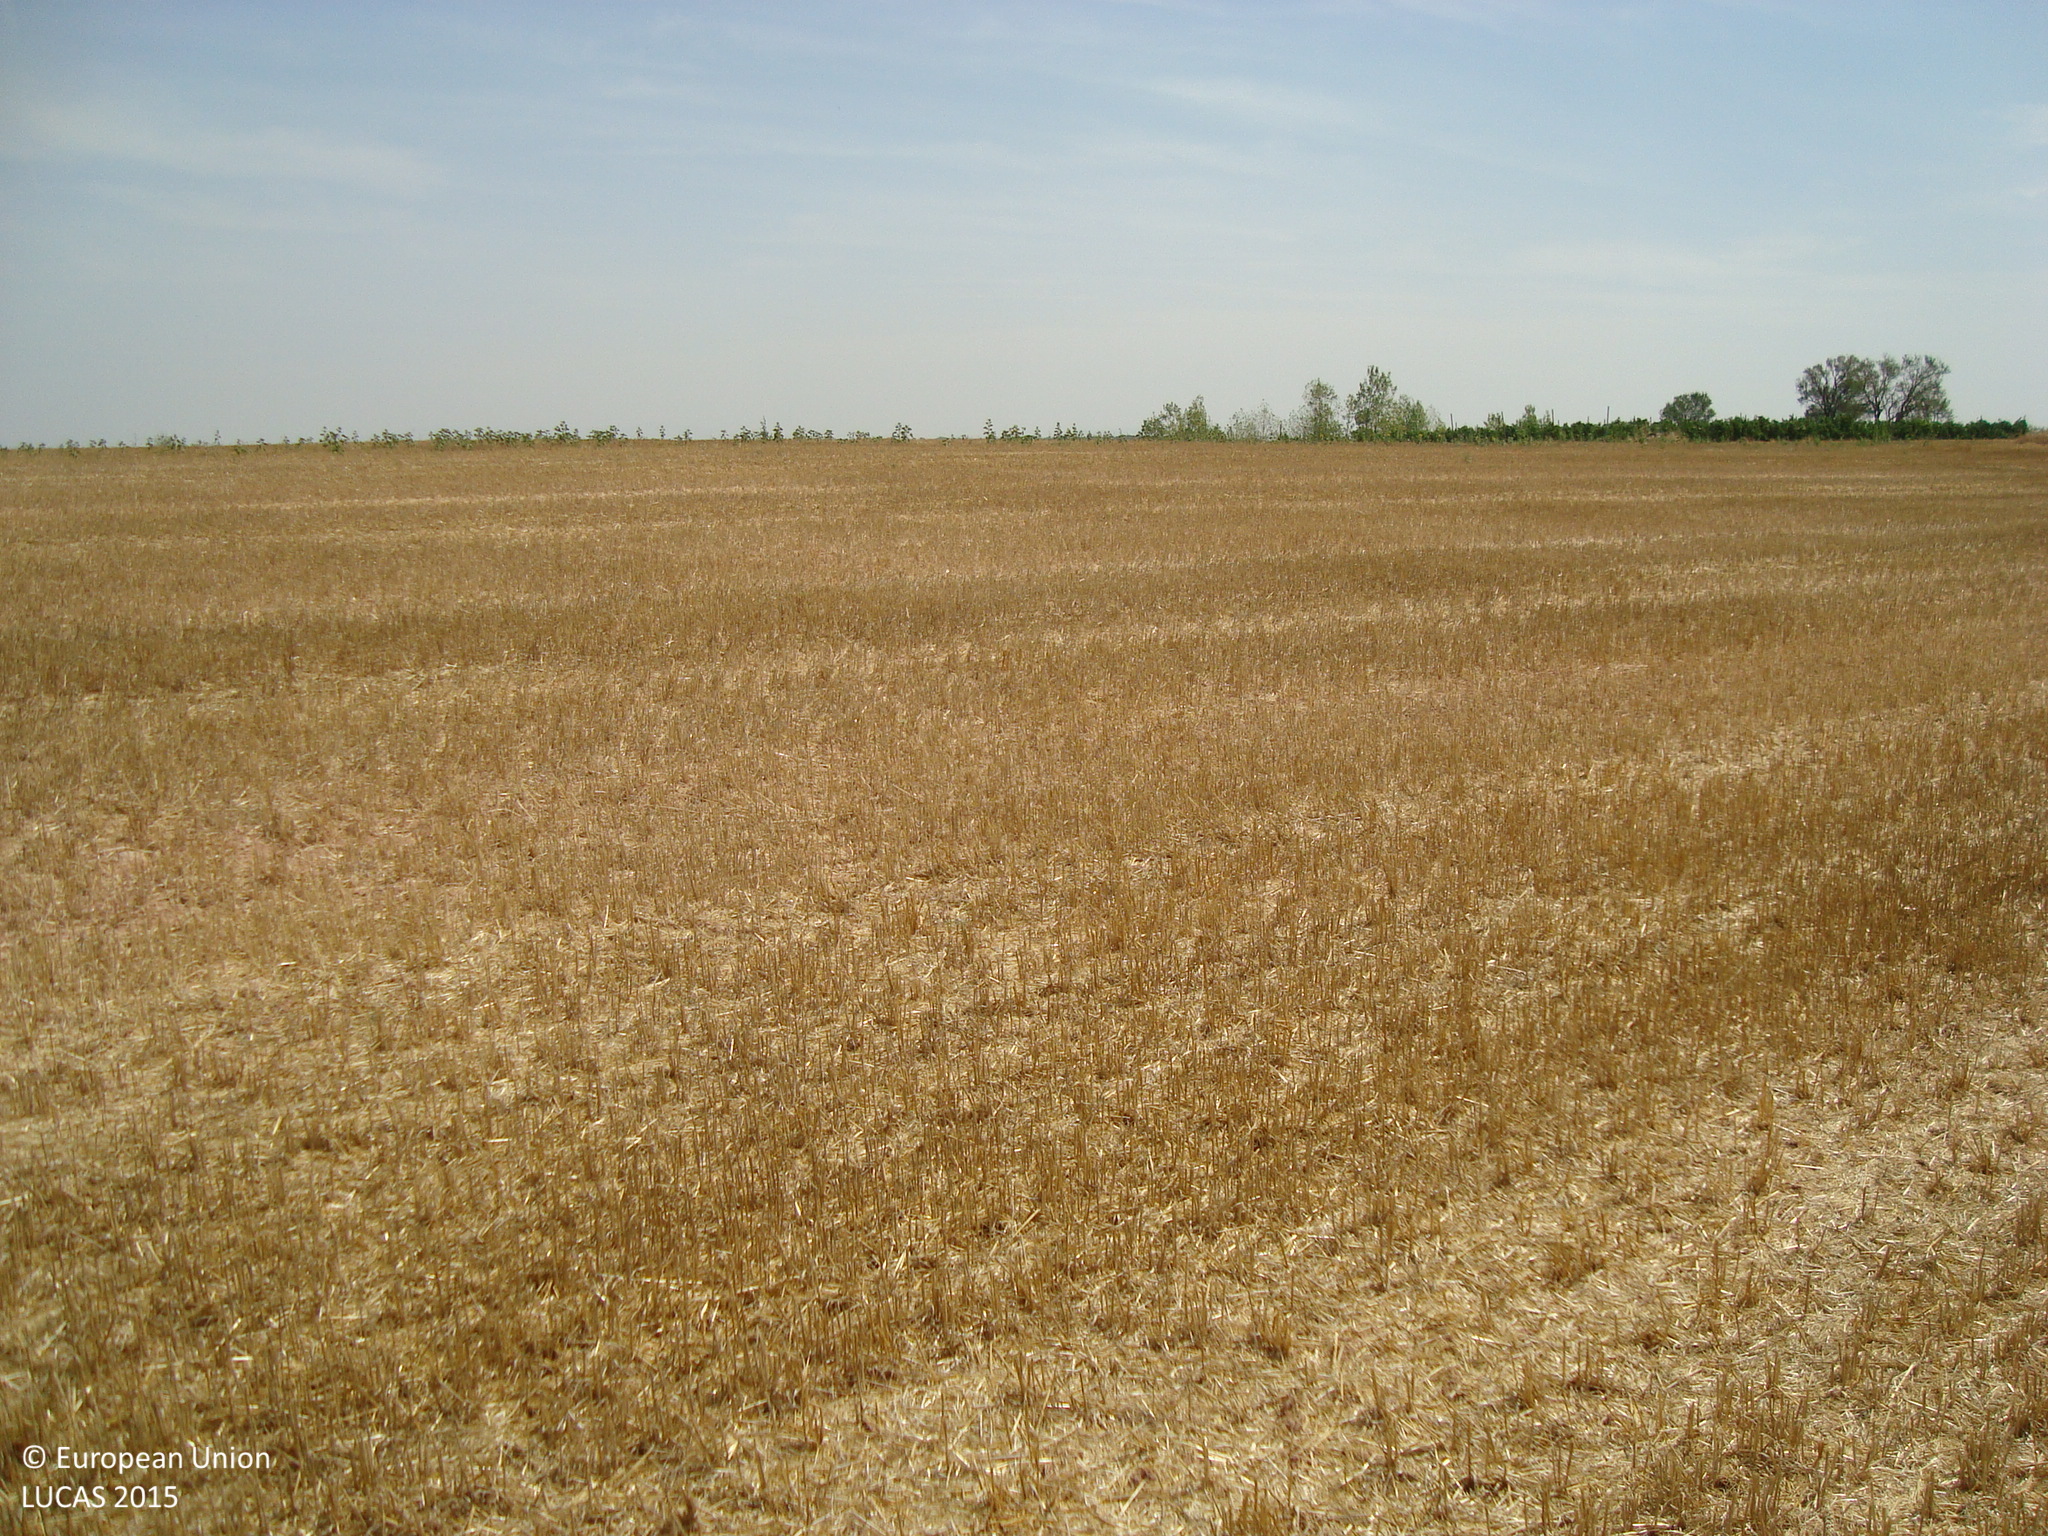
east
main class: Cropland
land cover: Common wheat
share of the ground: > 75 %
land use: Agriculture (excluding fallow land and kitchen gardens)
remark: Harvested field
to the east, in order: Common wheat; Barley; Sunflower
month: August
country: ES
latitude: 42.1388
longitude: -3.9642
